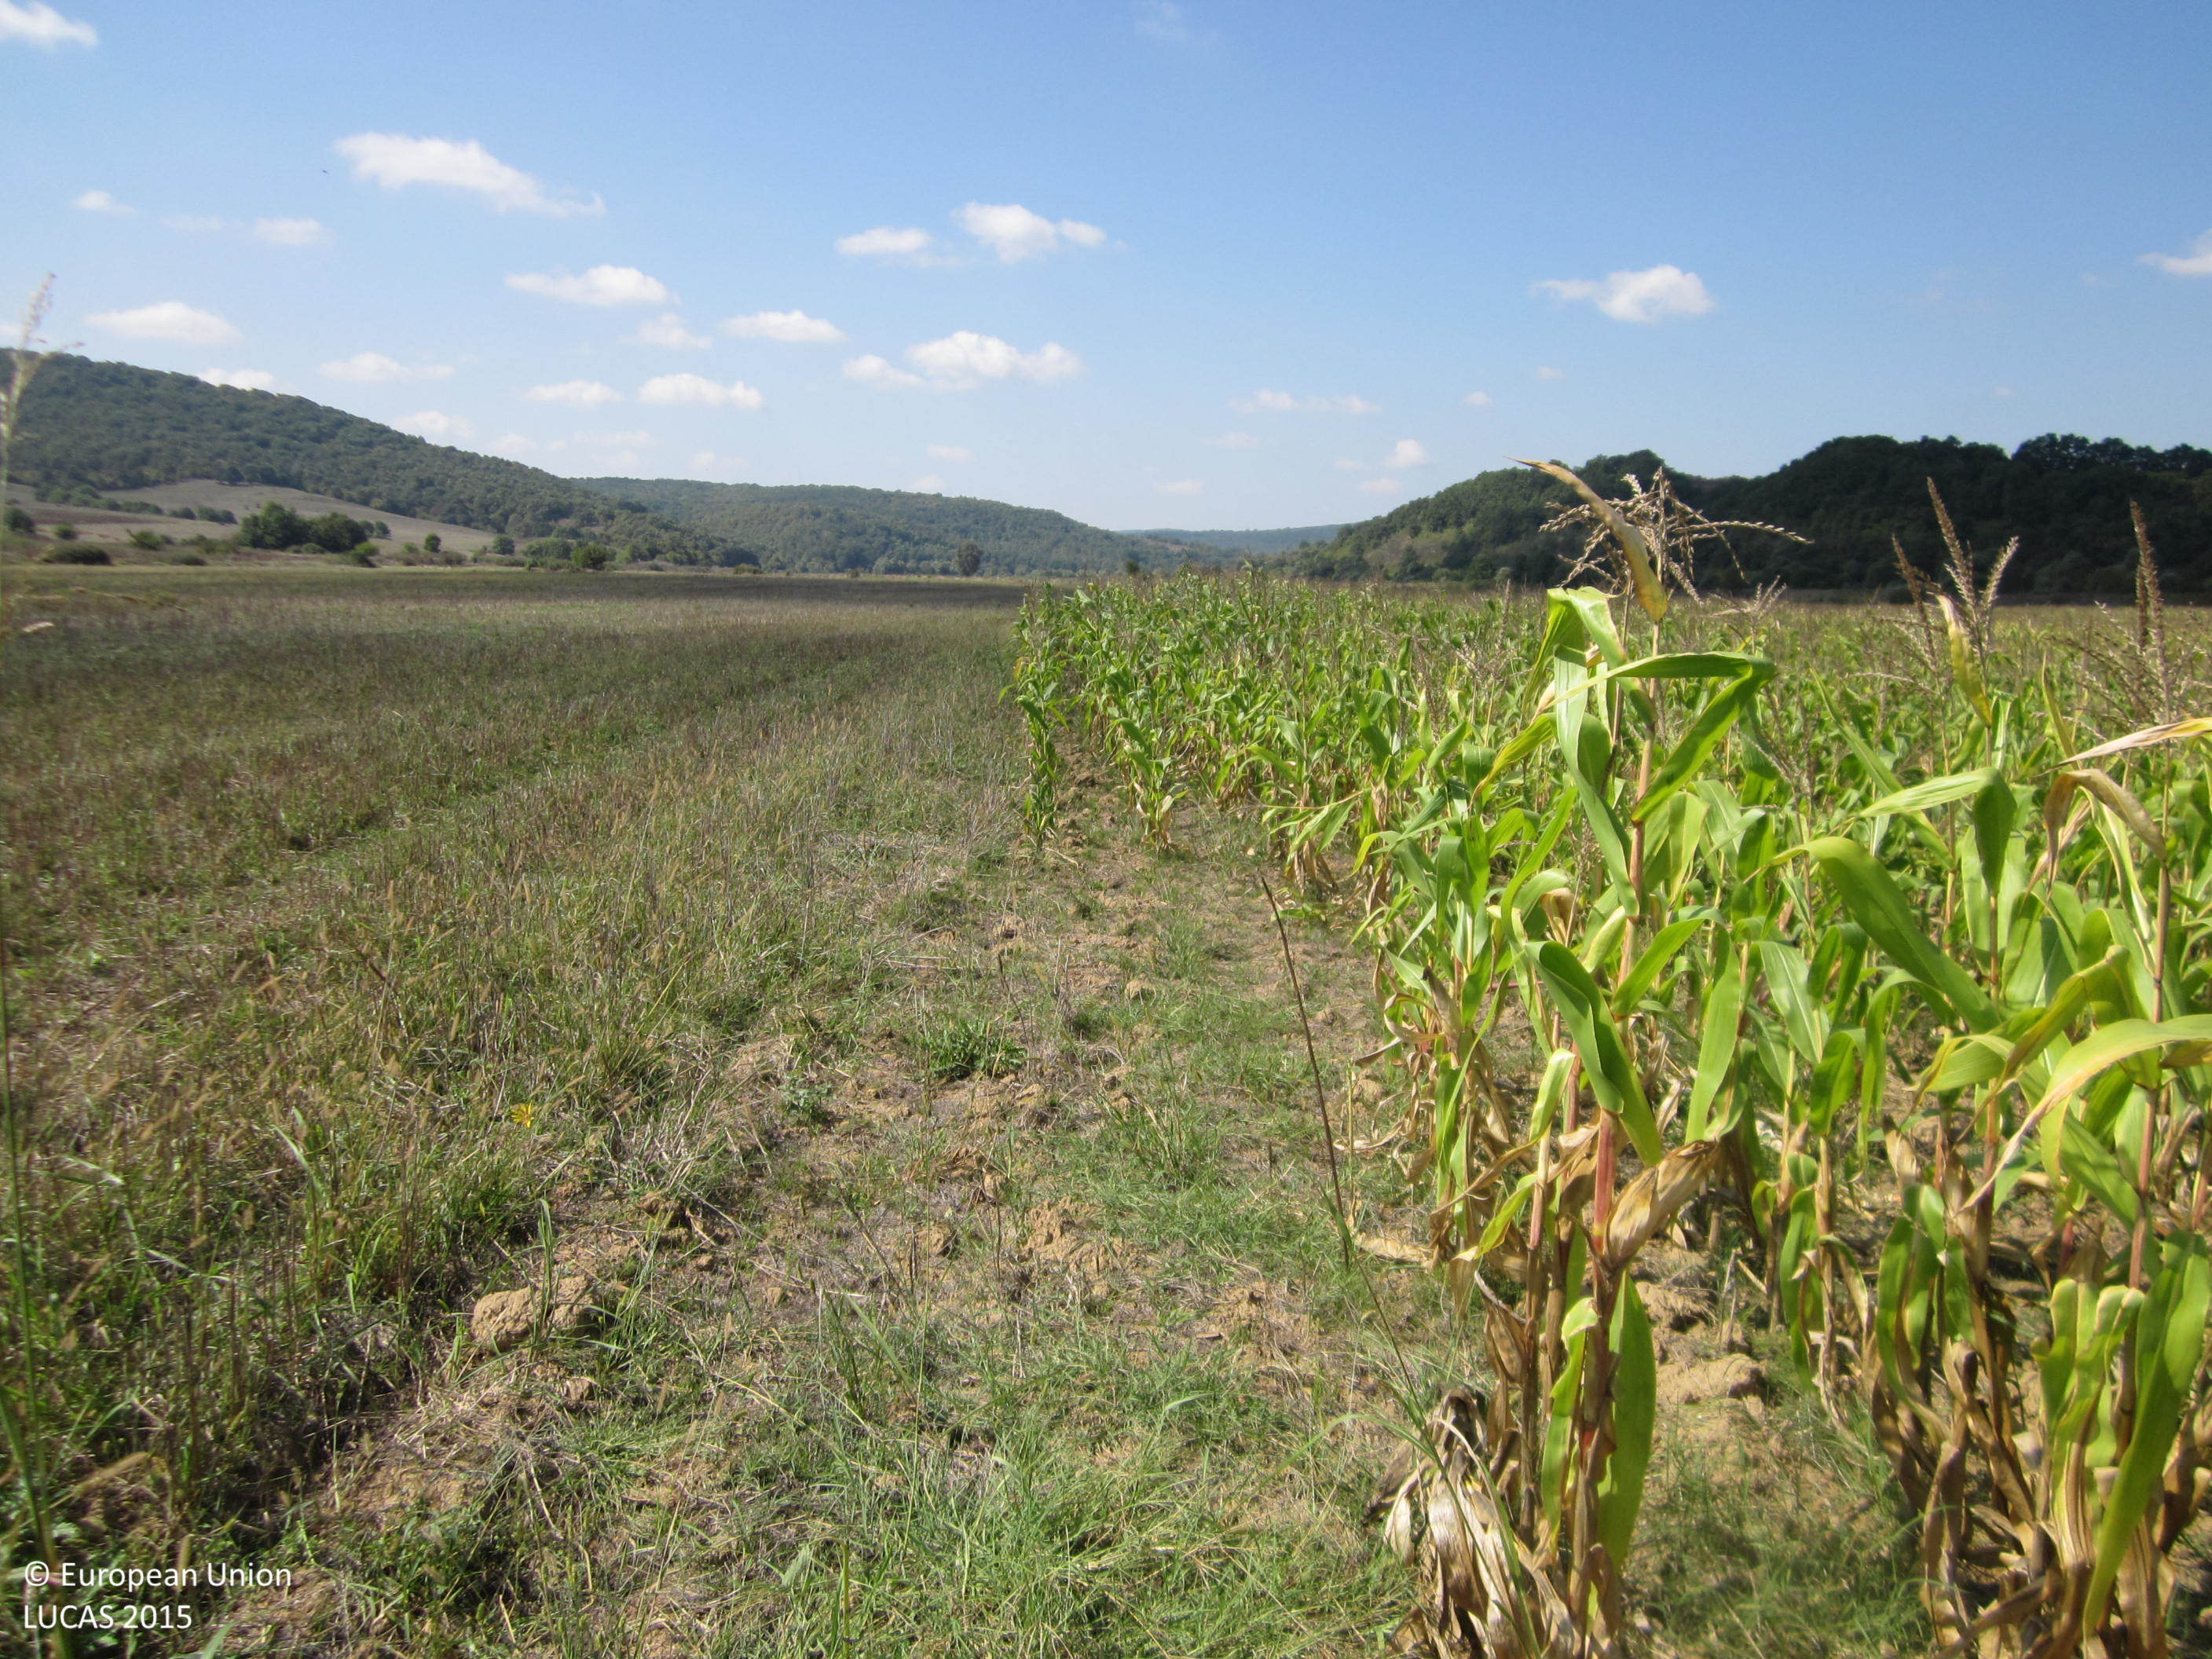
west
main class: Cropland
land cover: Maize
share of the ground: > 75 %
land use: Agriculture (excluding fallow land and kitchen gardens)
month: September
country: BG
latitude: 42.3219
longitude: 27.3540
